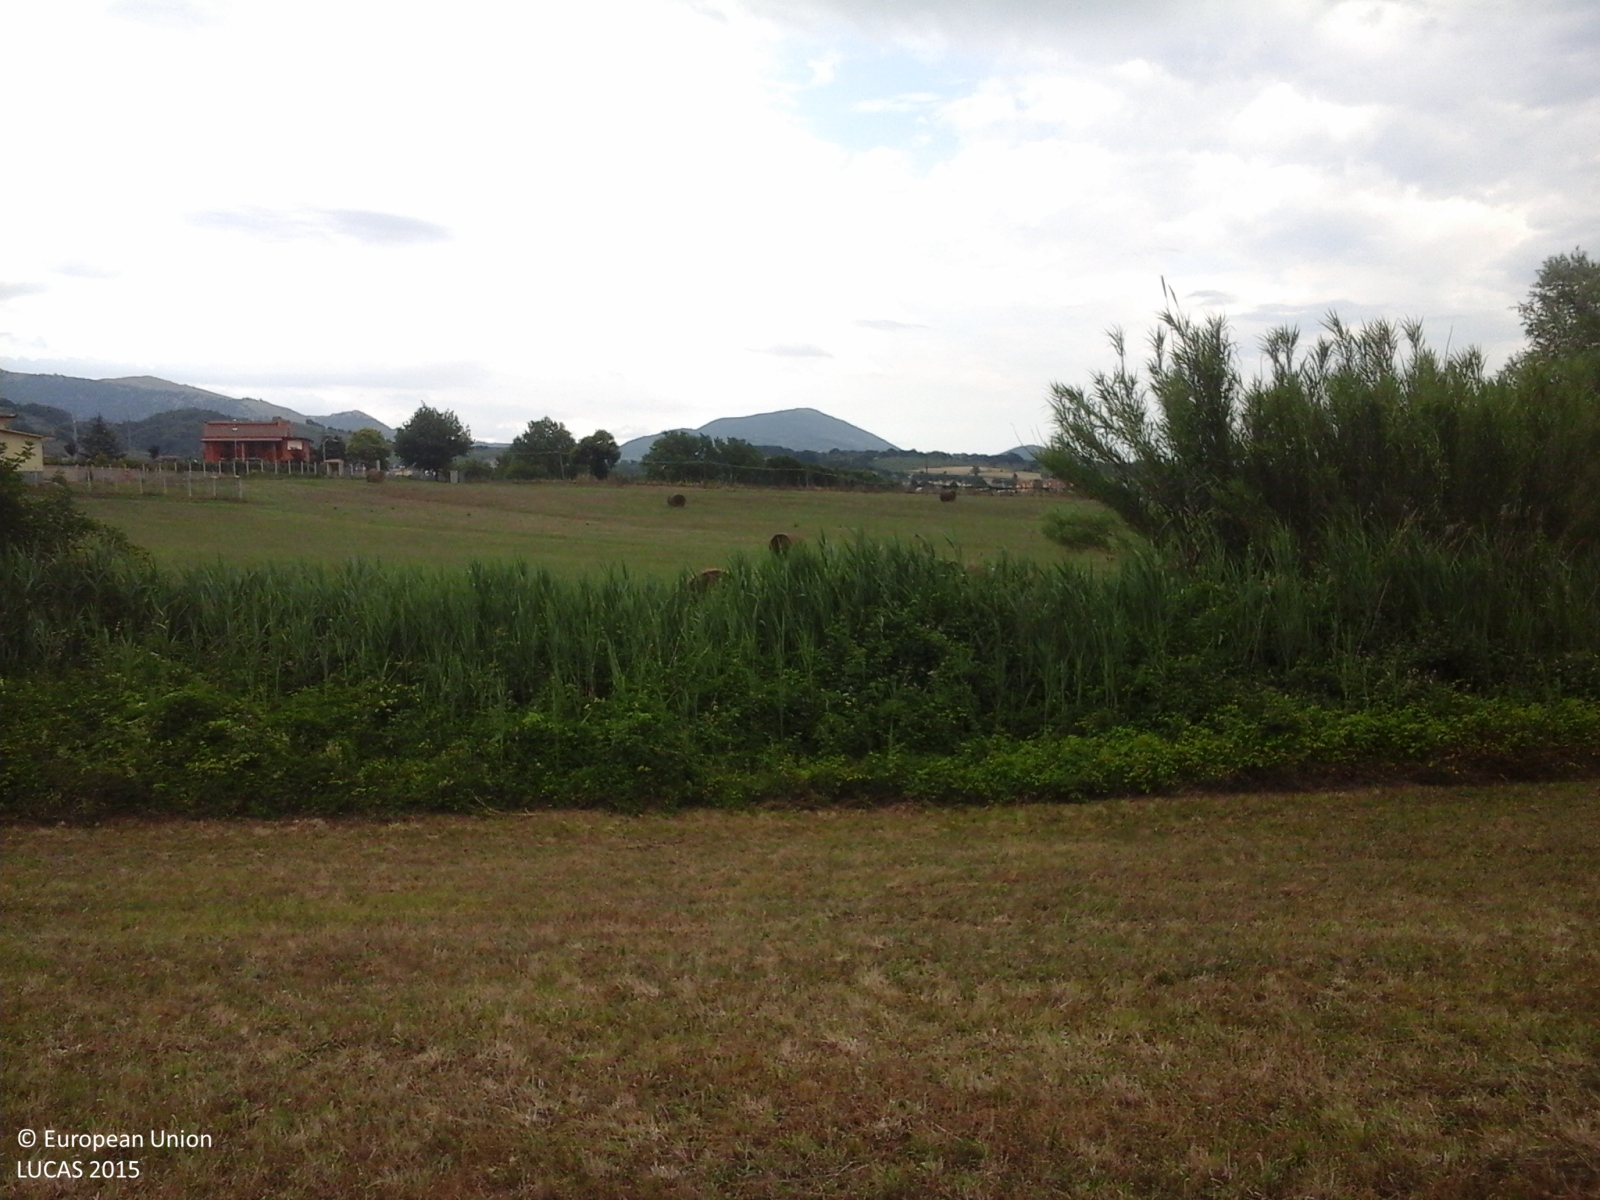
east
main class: Grassland
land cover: Spontaneously vegetated surfaces
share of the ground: > 75 %
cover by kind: herbaceous plants 100 %
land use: Agriculture (excluding fallow land and kitchen gardens)
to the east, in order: Spontaneously vegetated surfaces; Grassland without tree/shrub cover; Ditches and canals; Spontaneously vegetated surfaces; Artificial constructions in urban areas; Managed hedges; Grassland without tree/shrub cover; Artificial constructions in urban areas
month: June
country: IT
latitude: 41.7936
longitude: 13.0813
